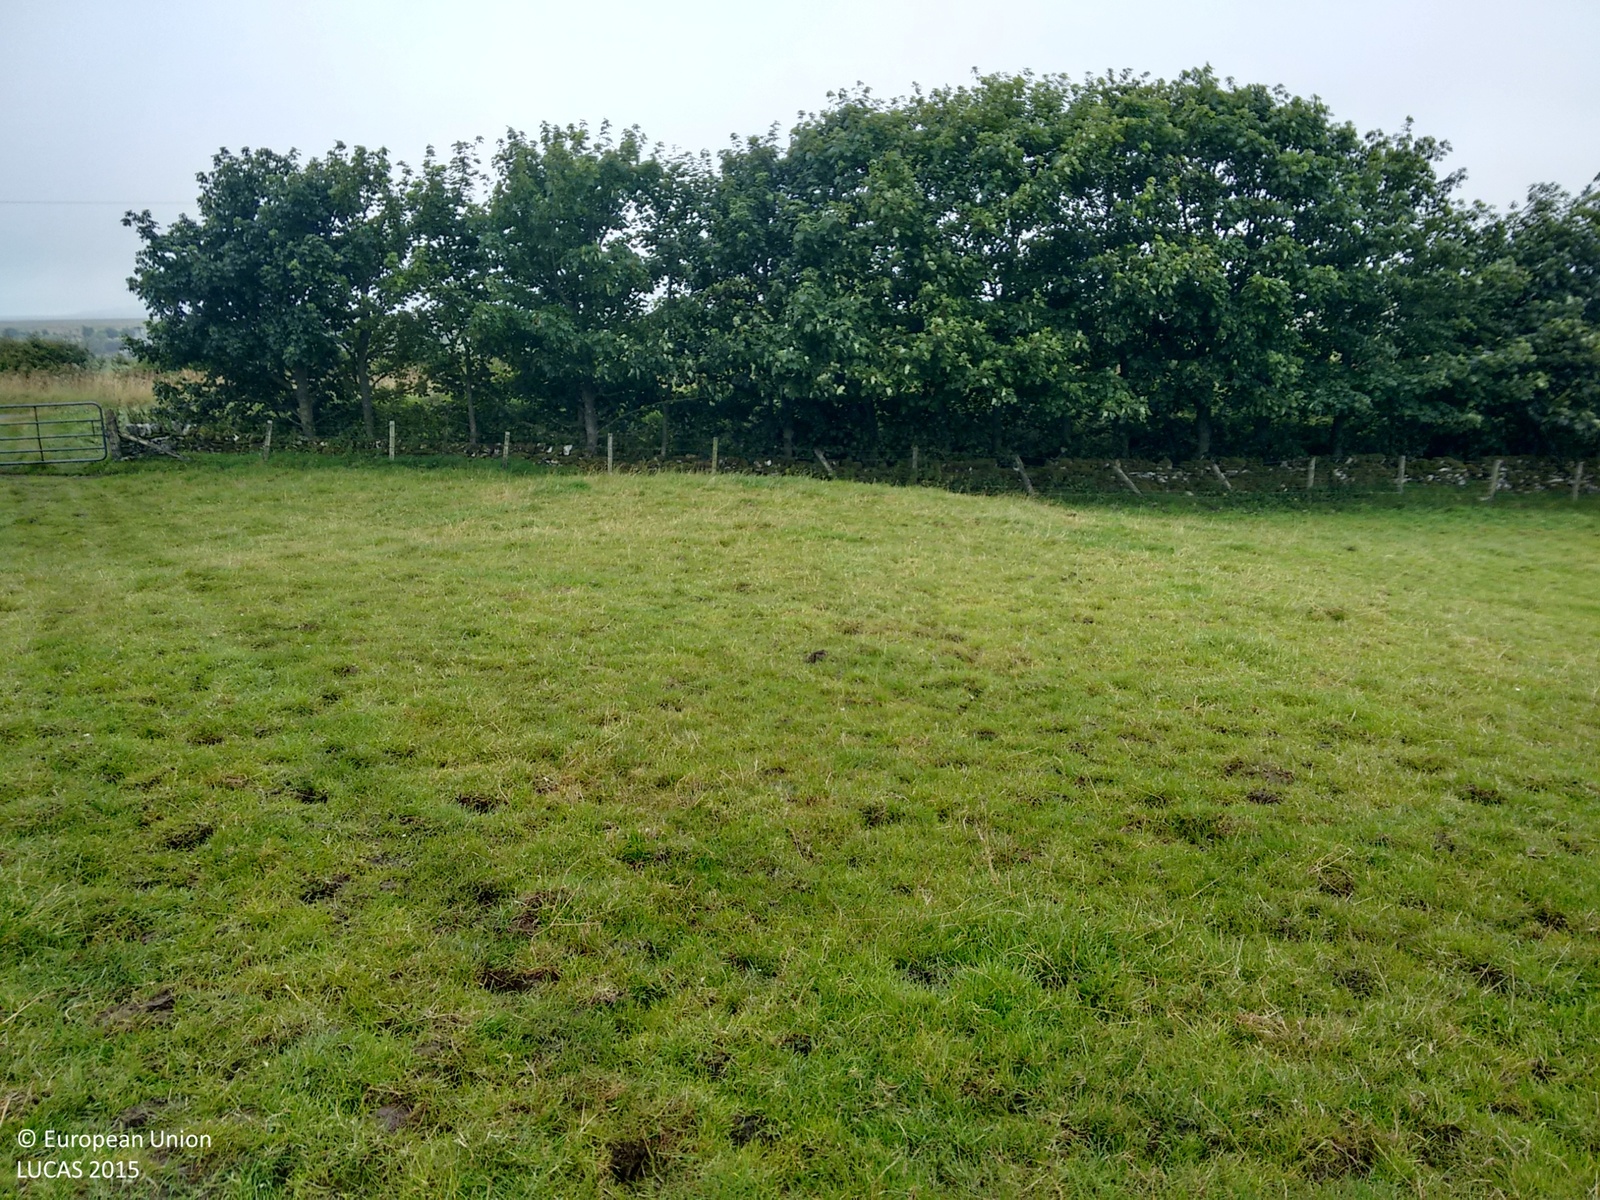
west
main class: Grassland
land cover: Grassland without tree/shrub cover
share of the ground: > 75 %
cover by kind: herbaceous plants 100 %
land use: Agriculture (excluding fallow land and kitchen gardens)
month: August
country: GB
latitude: 58.4526
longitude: -3.2727
